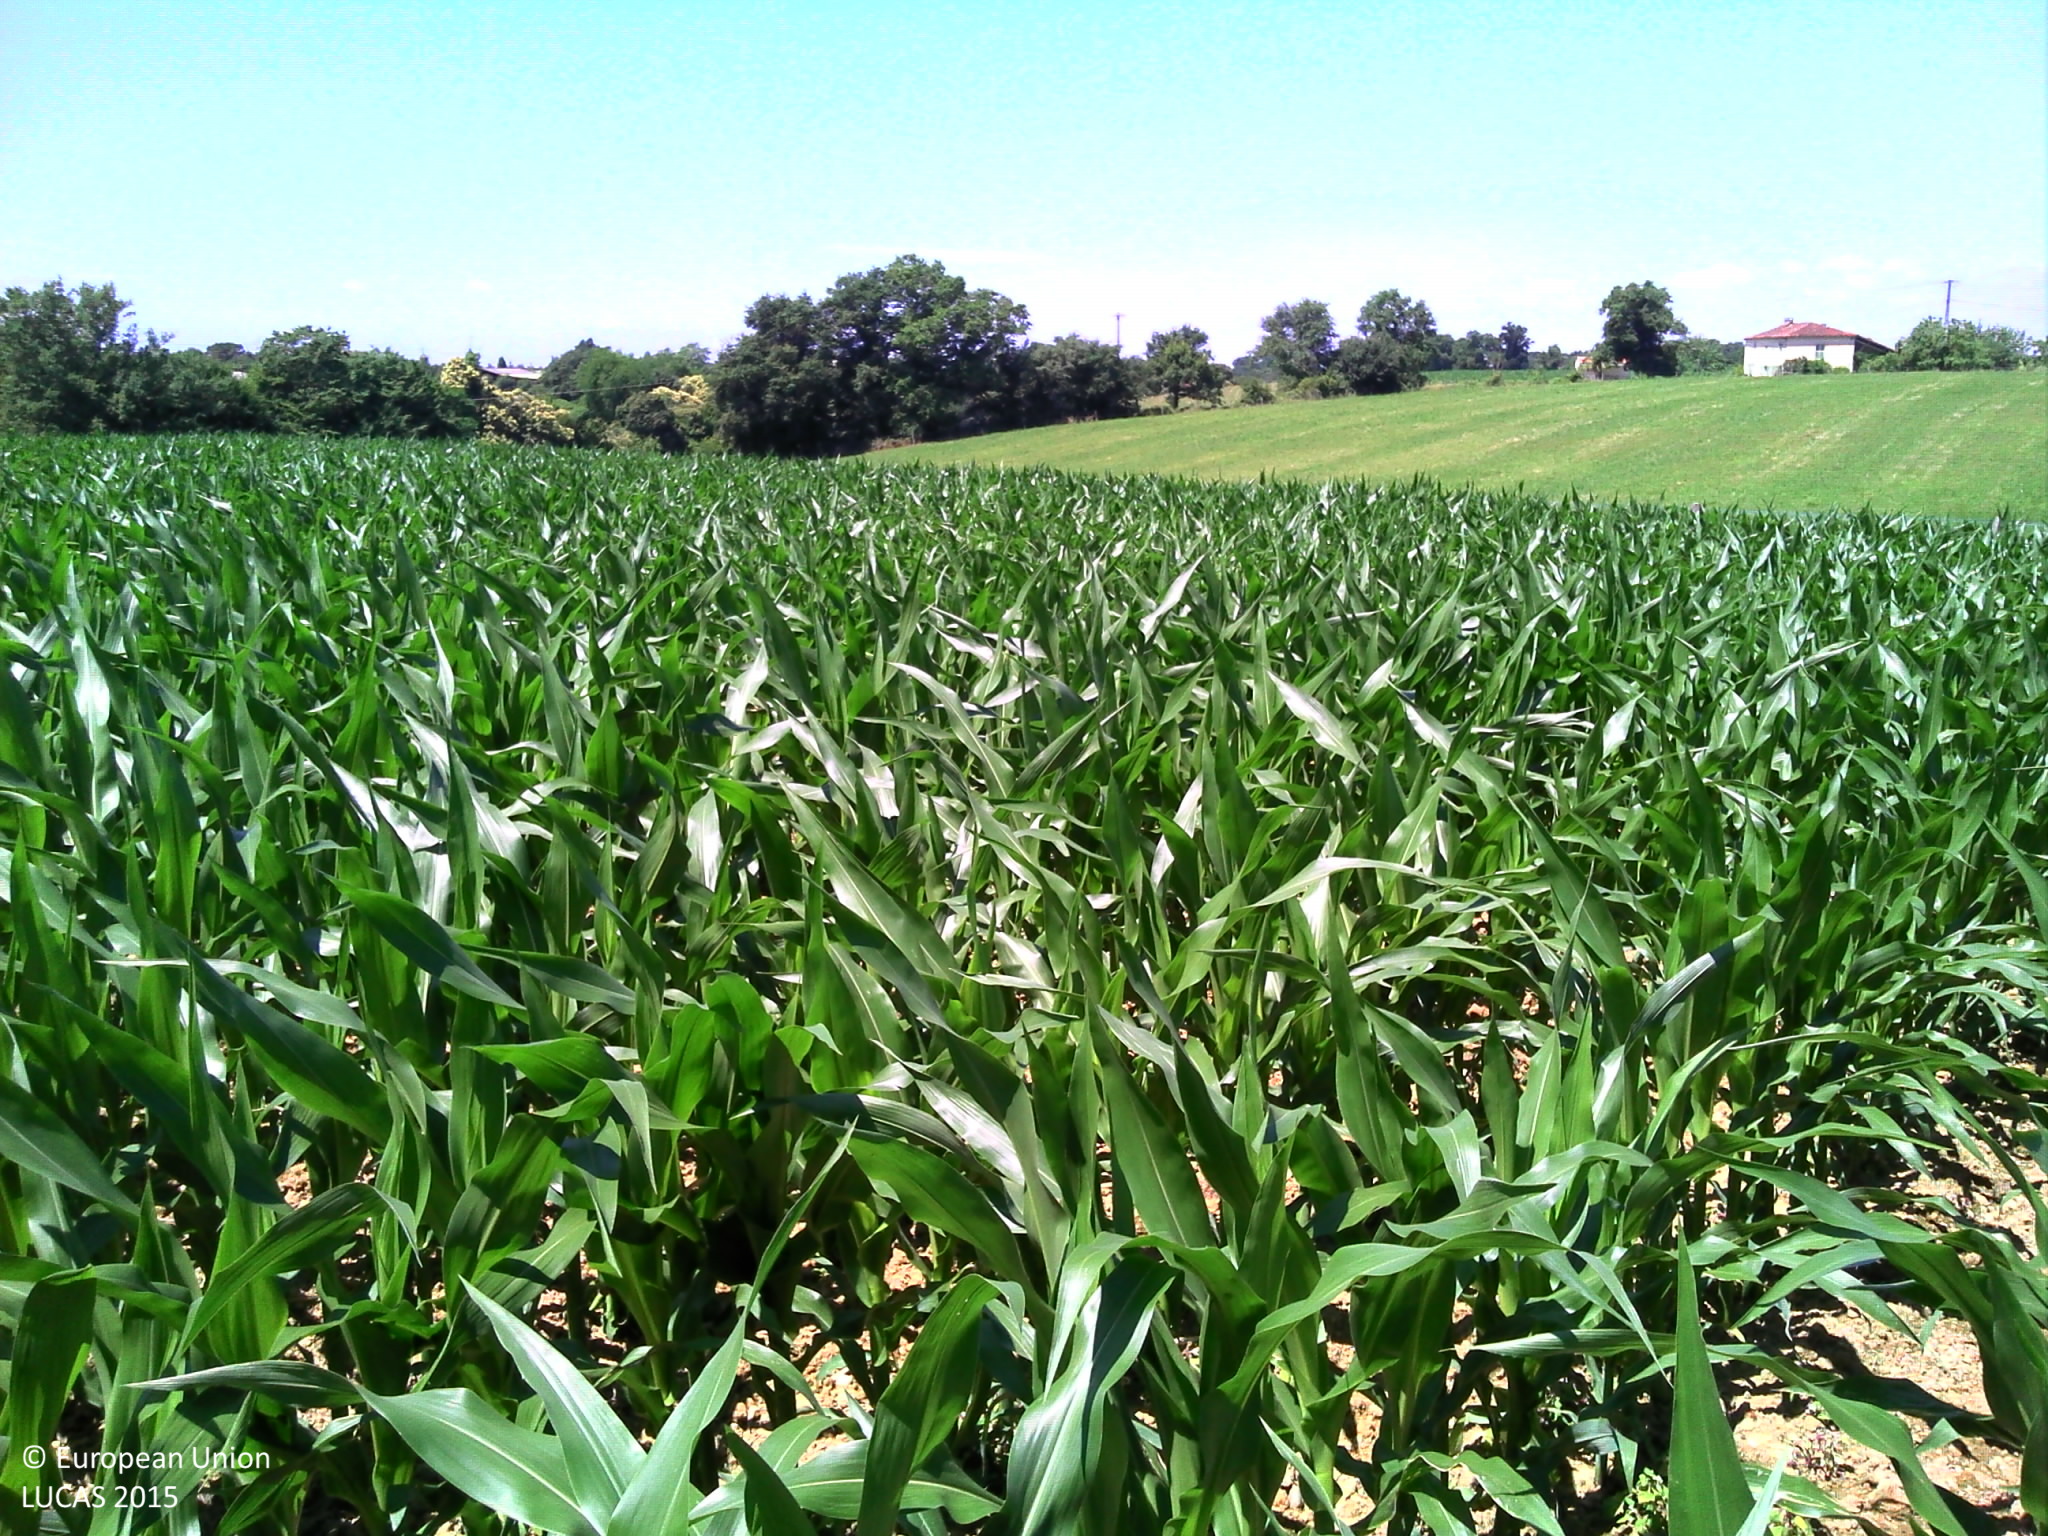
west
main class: Cropland
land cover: Maize
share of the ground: > 75 %
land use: Agriculture (excluding fallow land and kitchen gardens)
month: June
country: FR
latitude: 43.7637
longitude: -0.4823
